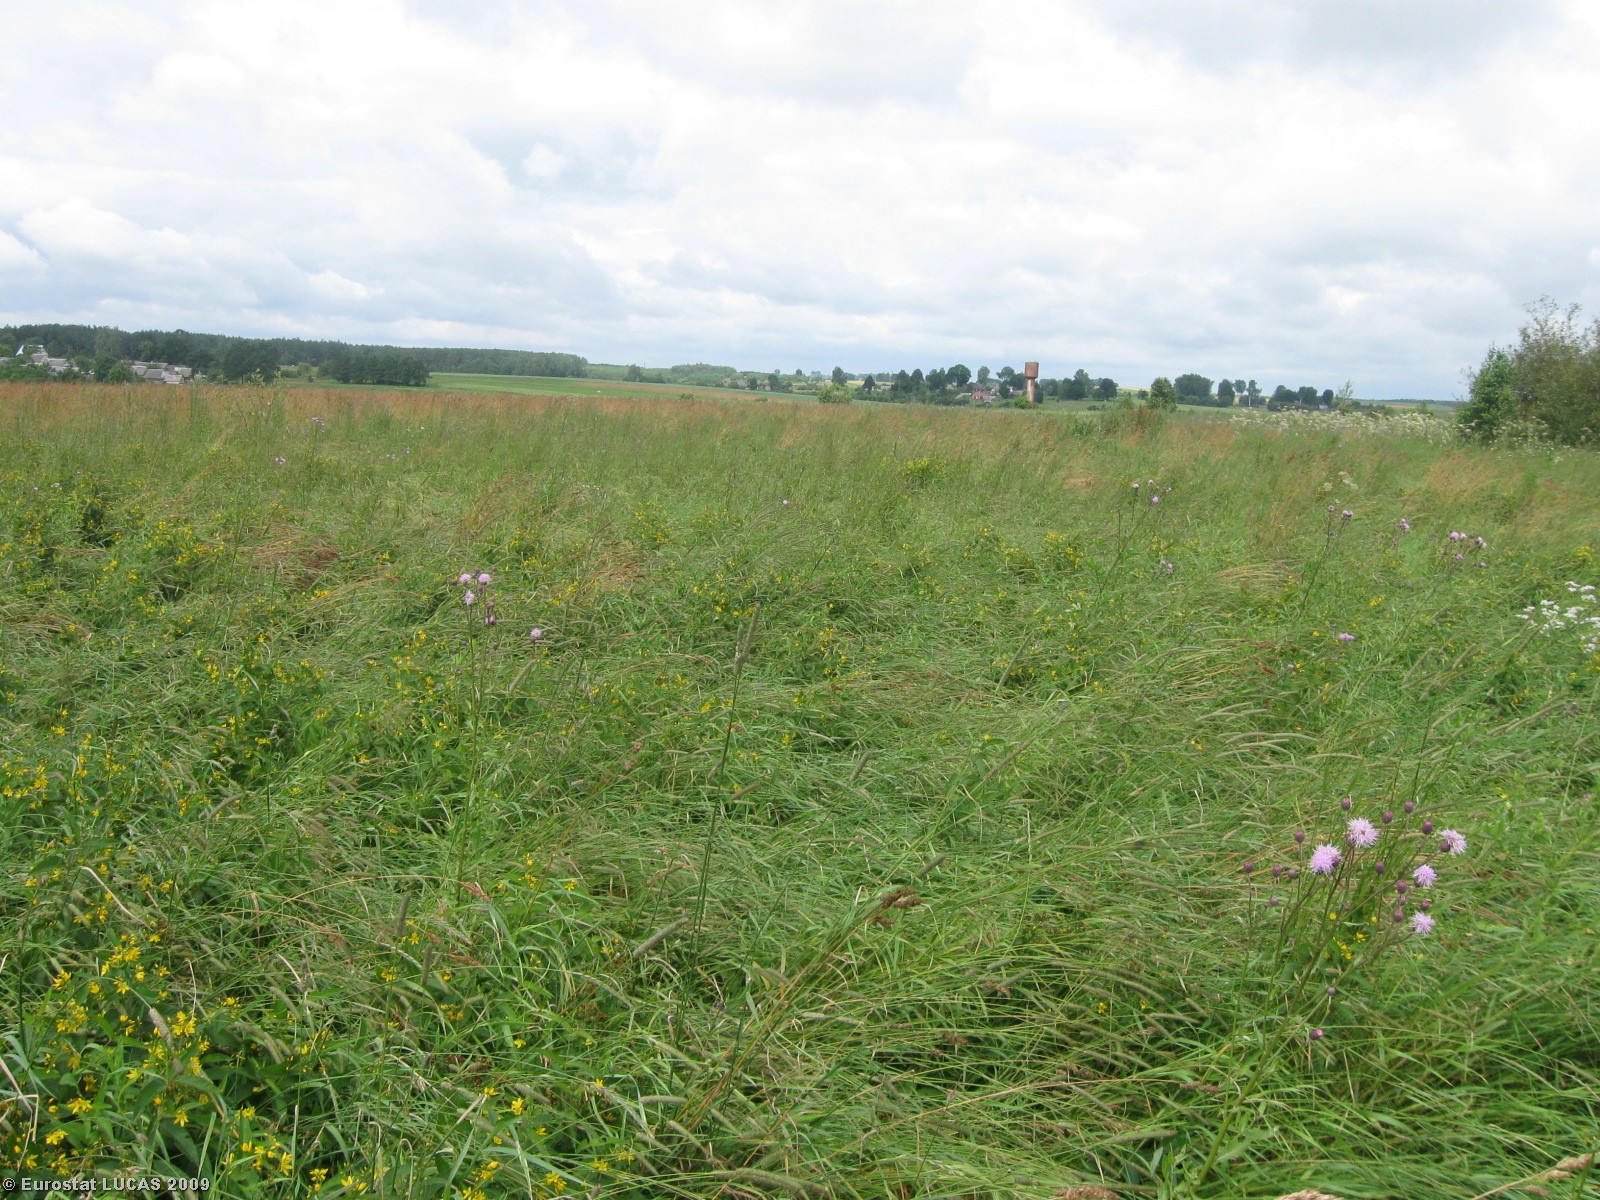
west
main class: Grassland
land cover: Spontaneously vegetated surfaces
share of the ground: > 75 %
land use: Fallow land
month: July
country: LT
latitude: 54.4307
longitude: 25.4965
